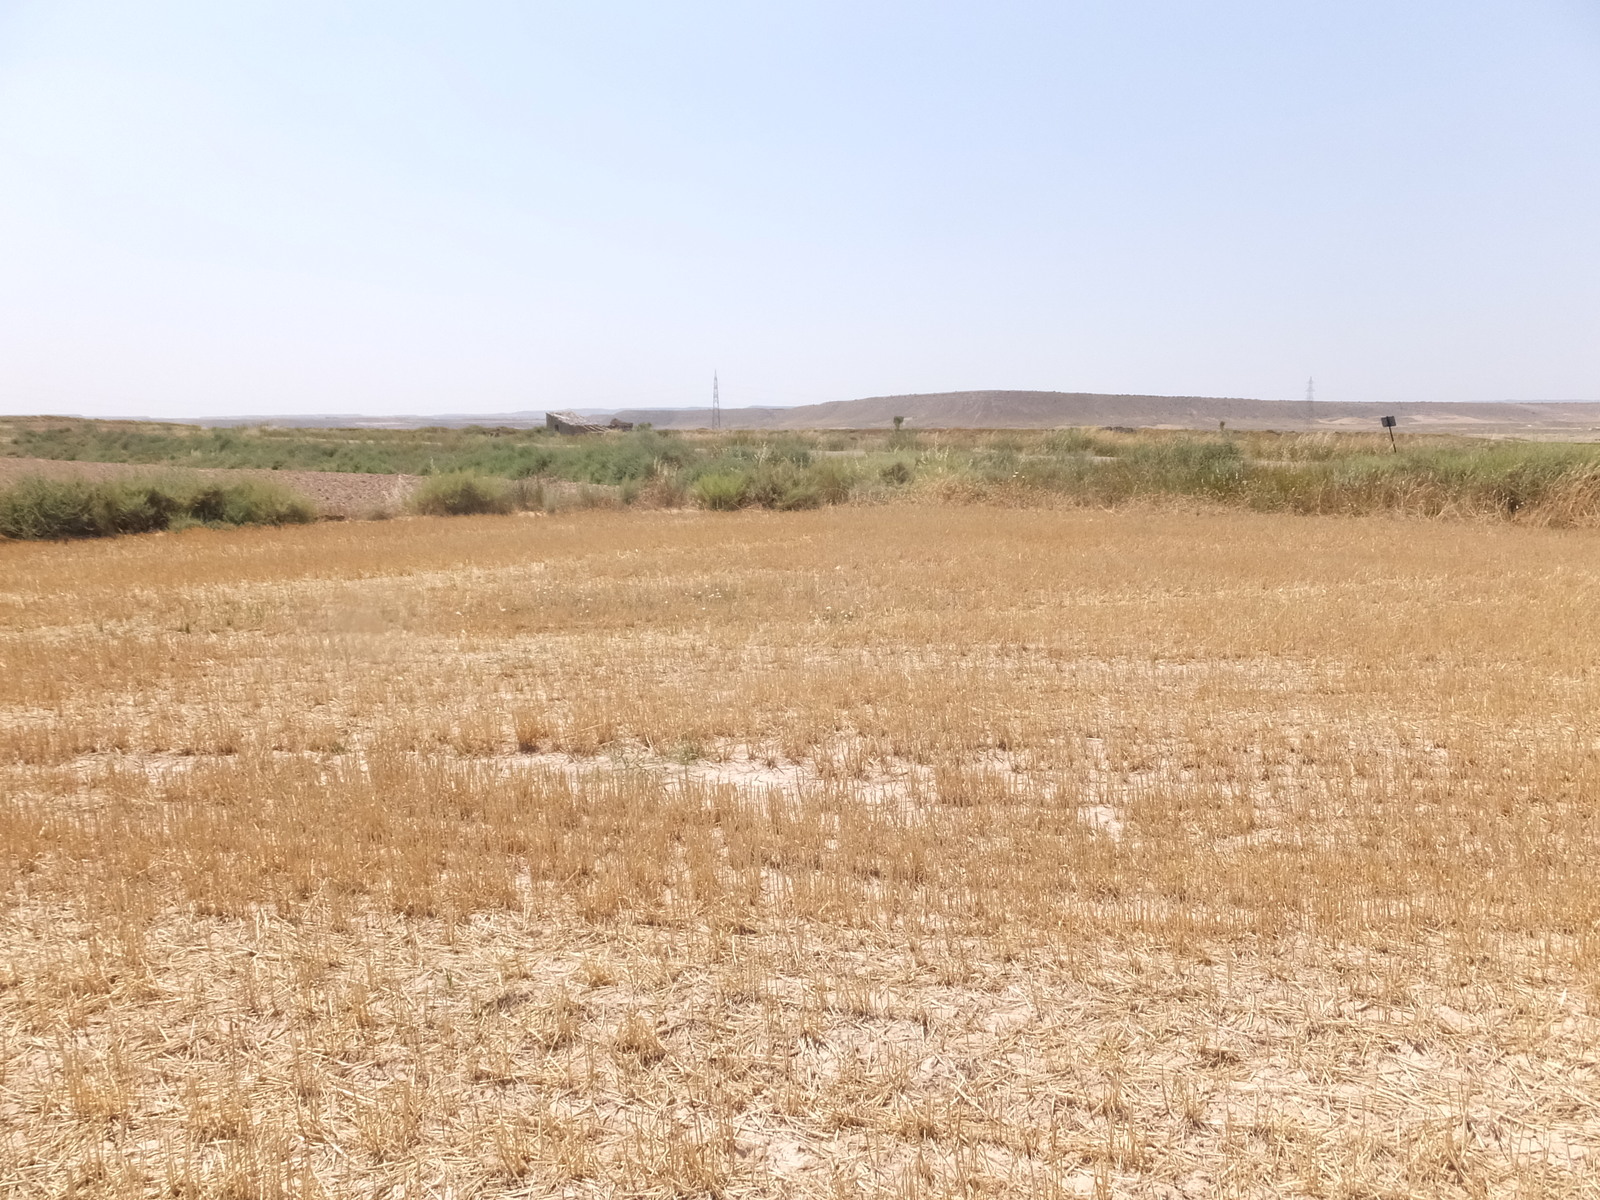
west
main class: Cropland
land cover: Barley
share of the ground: < 10 %
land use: Agriculture (excluding fallow land and kitchen gardens)
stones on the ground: < 10 %
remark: Harvested field
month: July
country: ES
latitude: 41.6098
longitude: 0.1576
